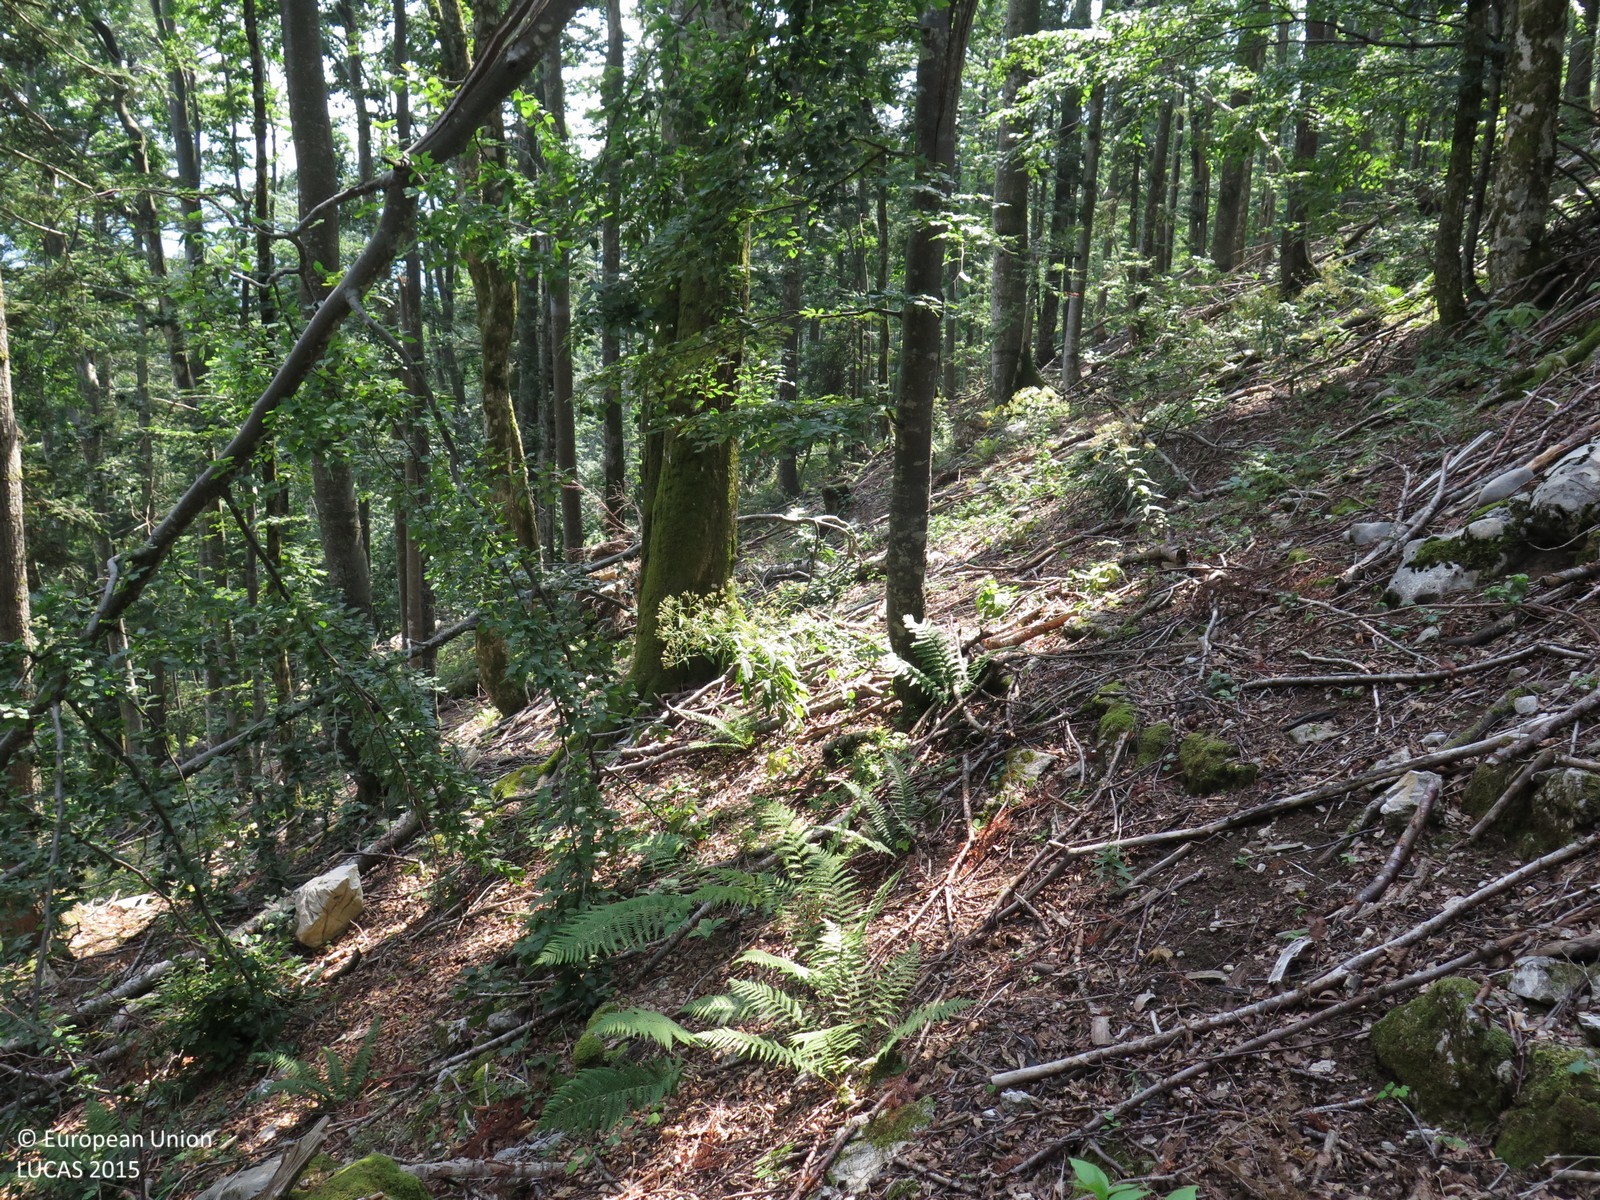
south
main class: Woodland
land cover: Broadleaved woodland
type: mountainous beech forest
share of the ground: > 75 %
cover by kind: broadleaved forest trees 95 %, herbaceous plants 5 %
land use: Forestry
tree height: > 5 m
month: August
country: HR
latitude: 45.4949
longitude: 14.5893
